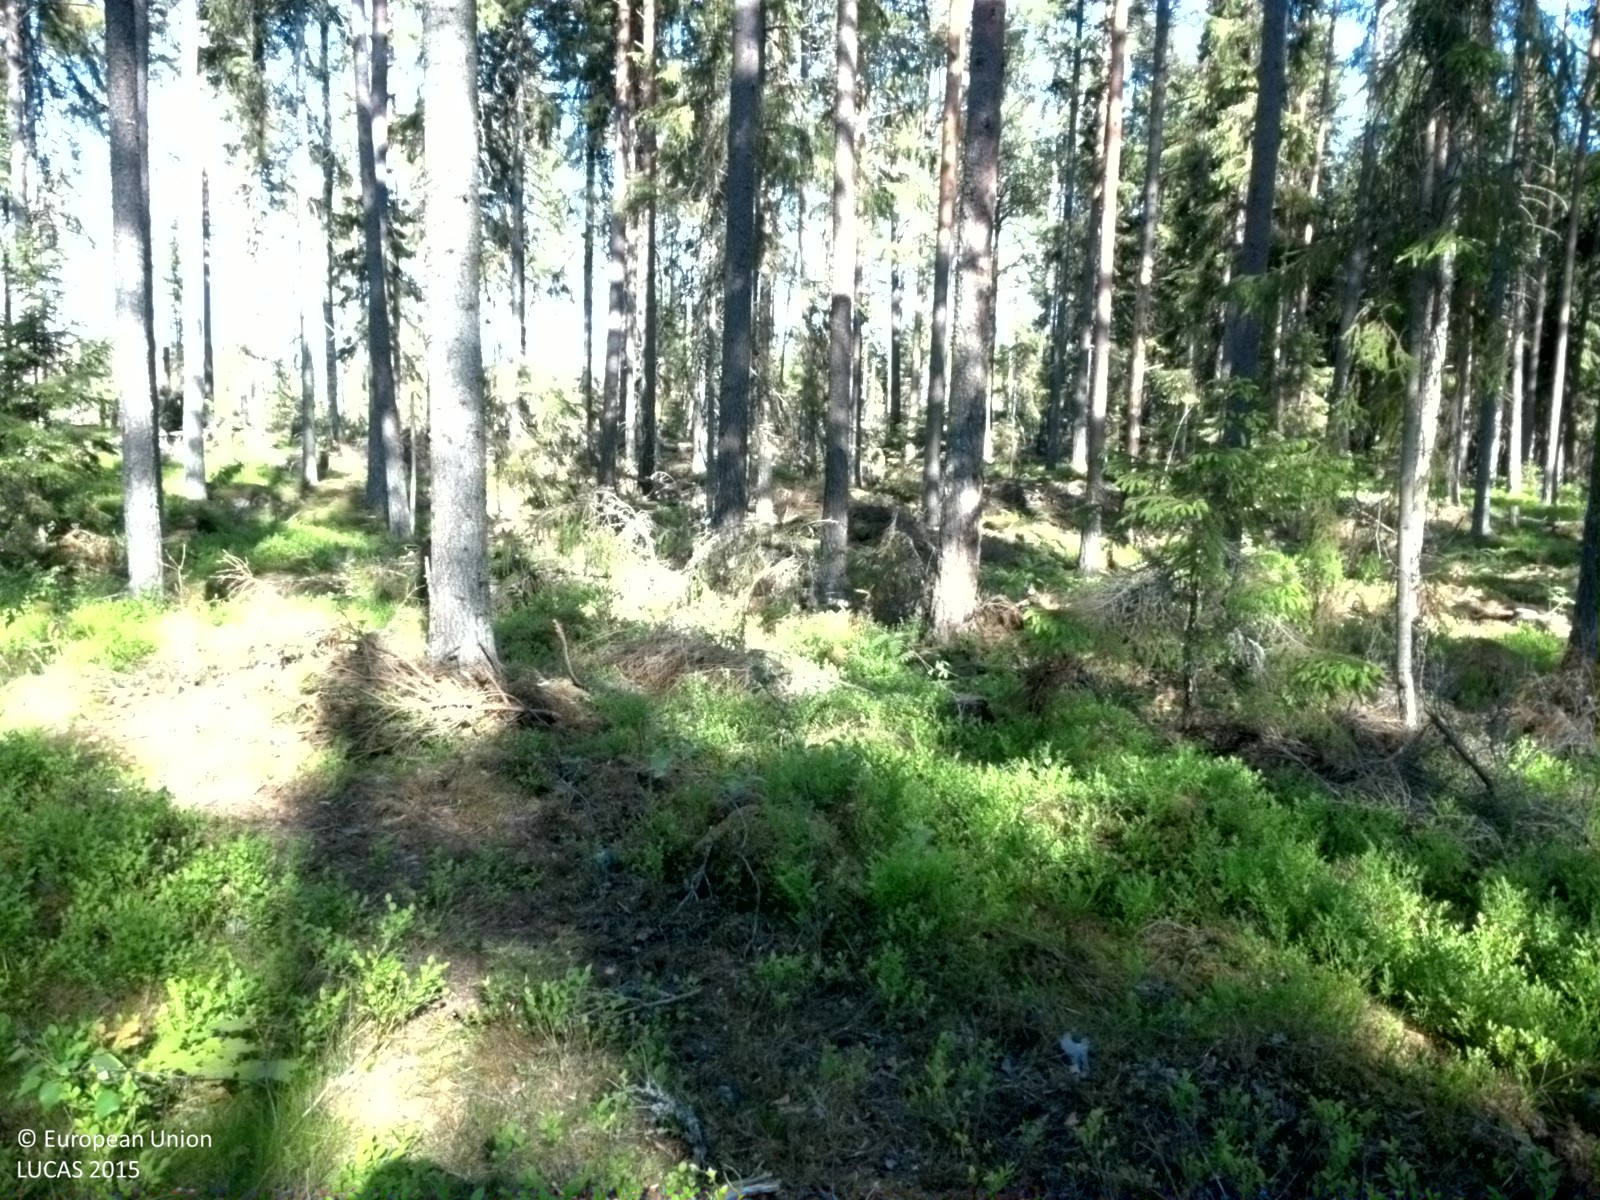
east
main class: Woodland
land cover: Pine dominated coniferous woodland
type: boreal forest
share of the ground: 50 - 75 %
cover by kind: coniferous forest trees 50 %, shrubs 20 %, consolidated bare surface 10 %, herbaceous plants 5 %, lichens and mosses 5 %
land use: Forestry
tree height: > 5 m
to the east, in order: Pine dominated coniferous woodland; Other coniferous woodland; Pine dominated coniferous woodland; Grassland with sparse tree/shrub cover; Shrubland with sparse tree cover; Other coniferous woodland
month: June
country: SE
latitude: 60.1699
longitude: 17.6888
